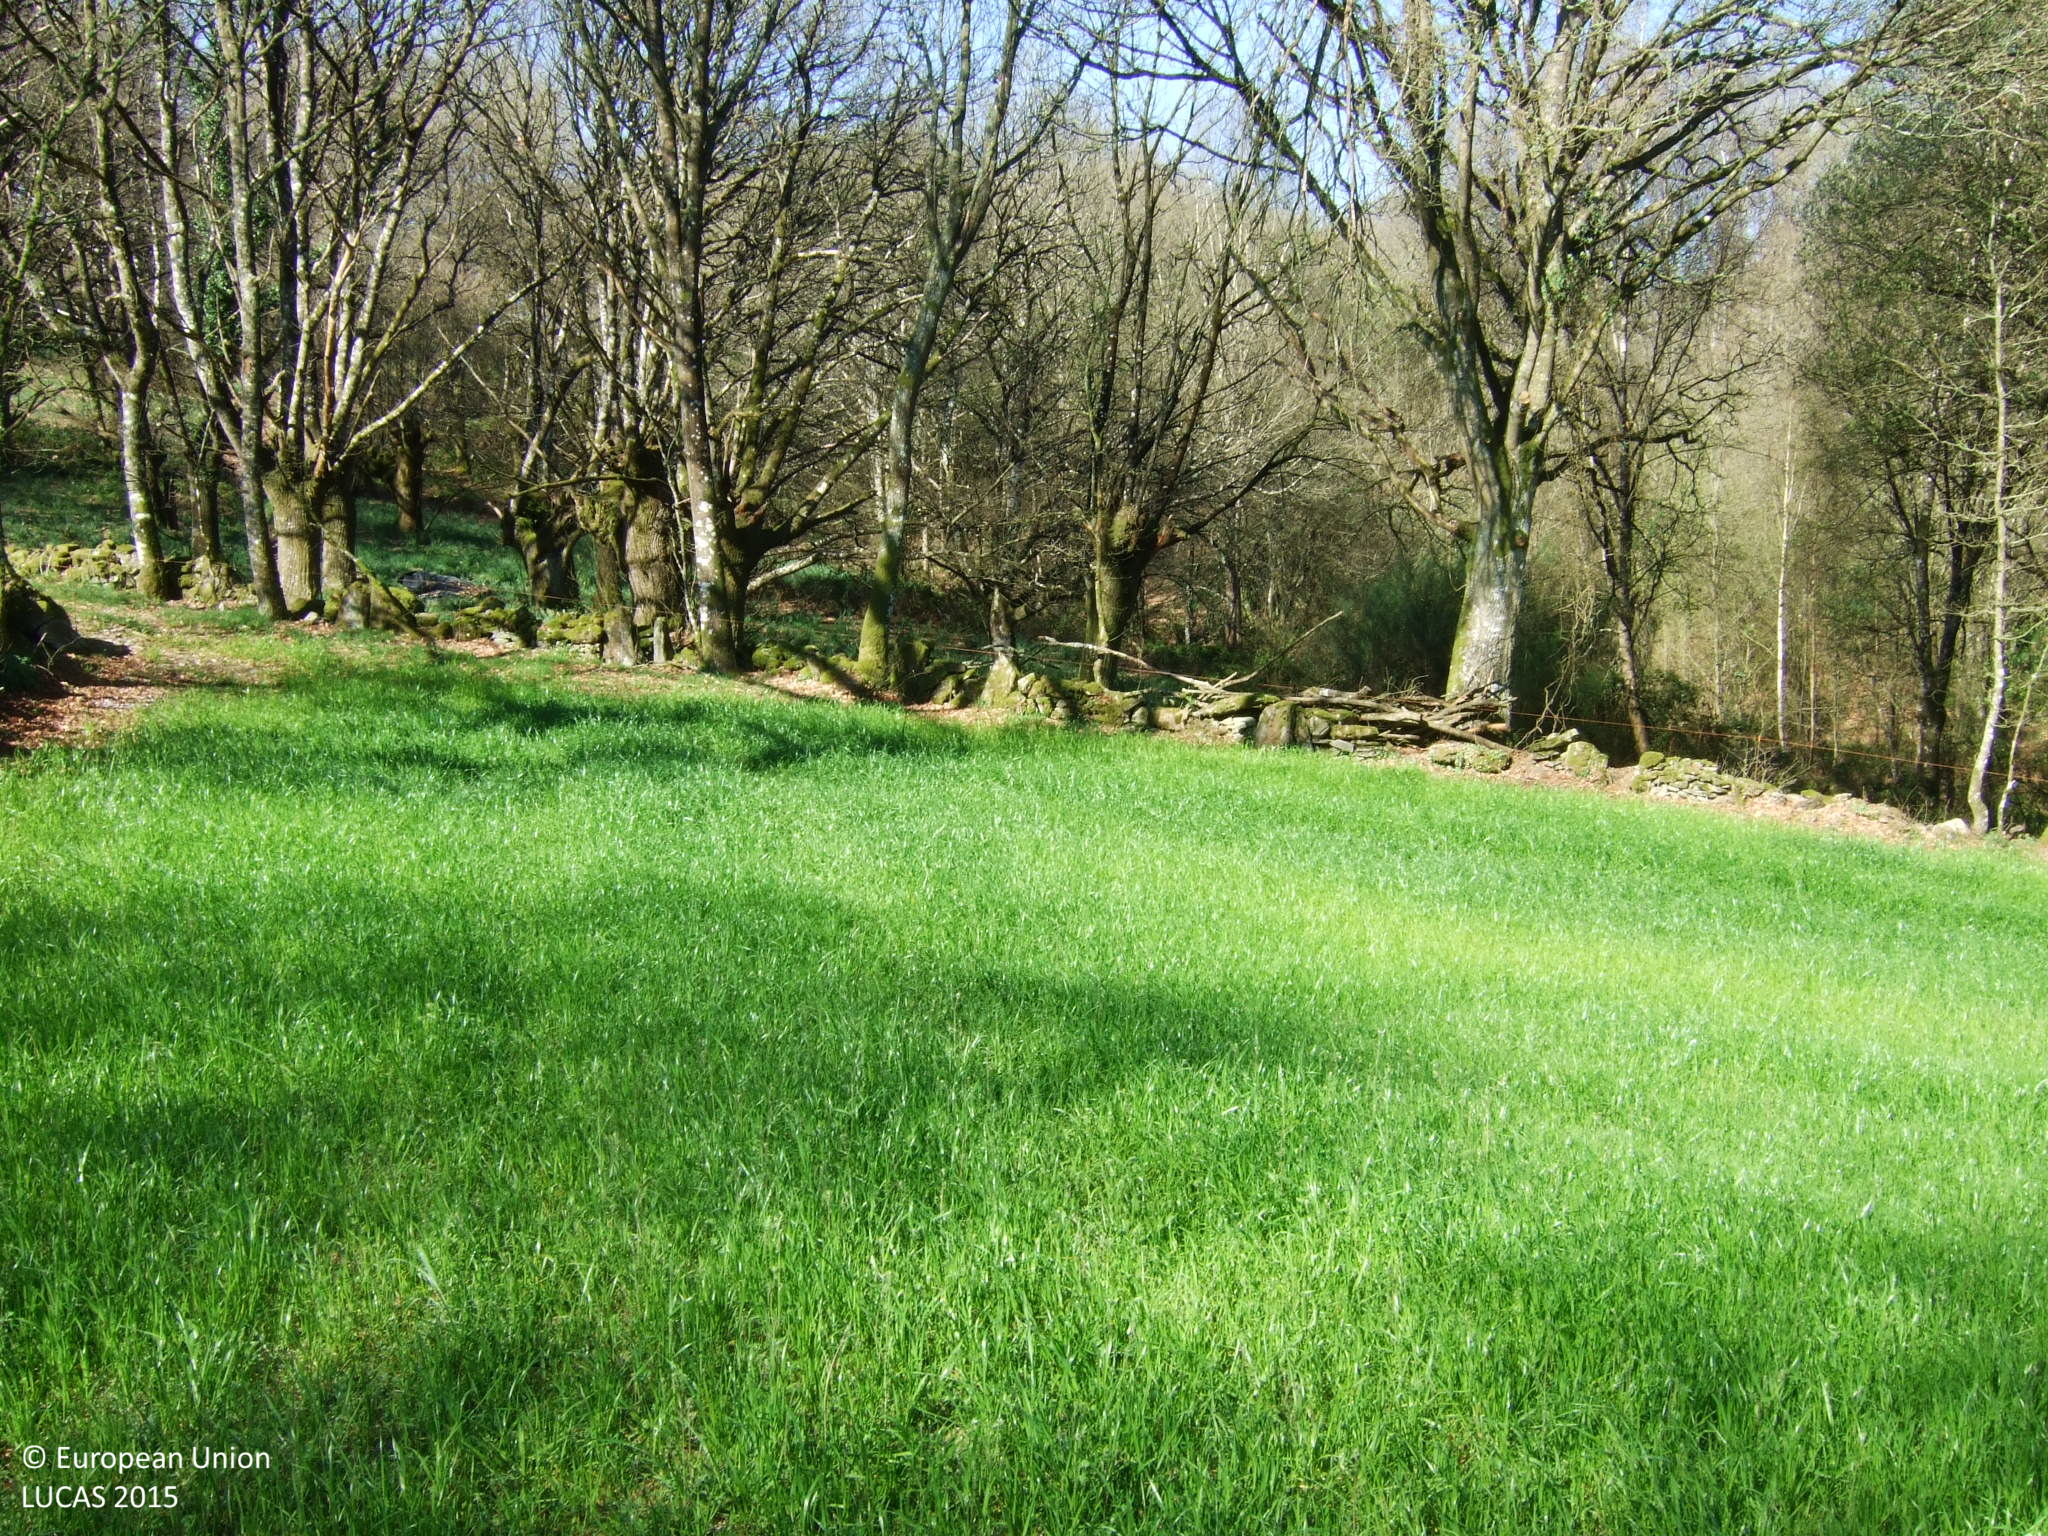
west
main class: Cropland
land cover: Temporary grasslands
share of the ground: > 75 %
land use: Agriculture (excluding fallow land and kitchen gardens)
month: April
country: ES
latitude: 42.7358
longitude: -7.8291
